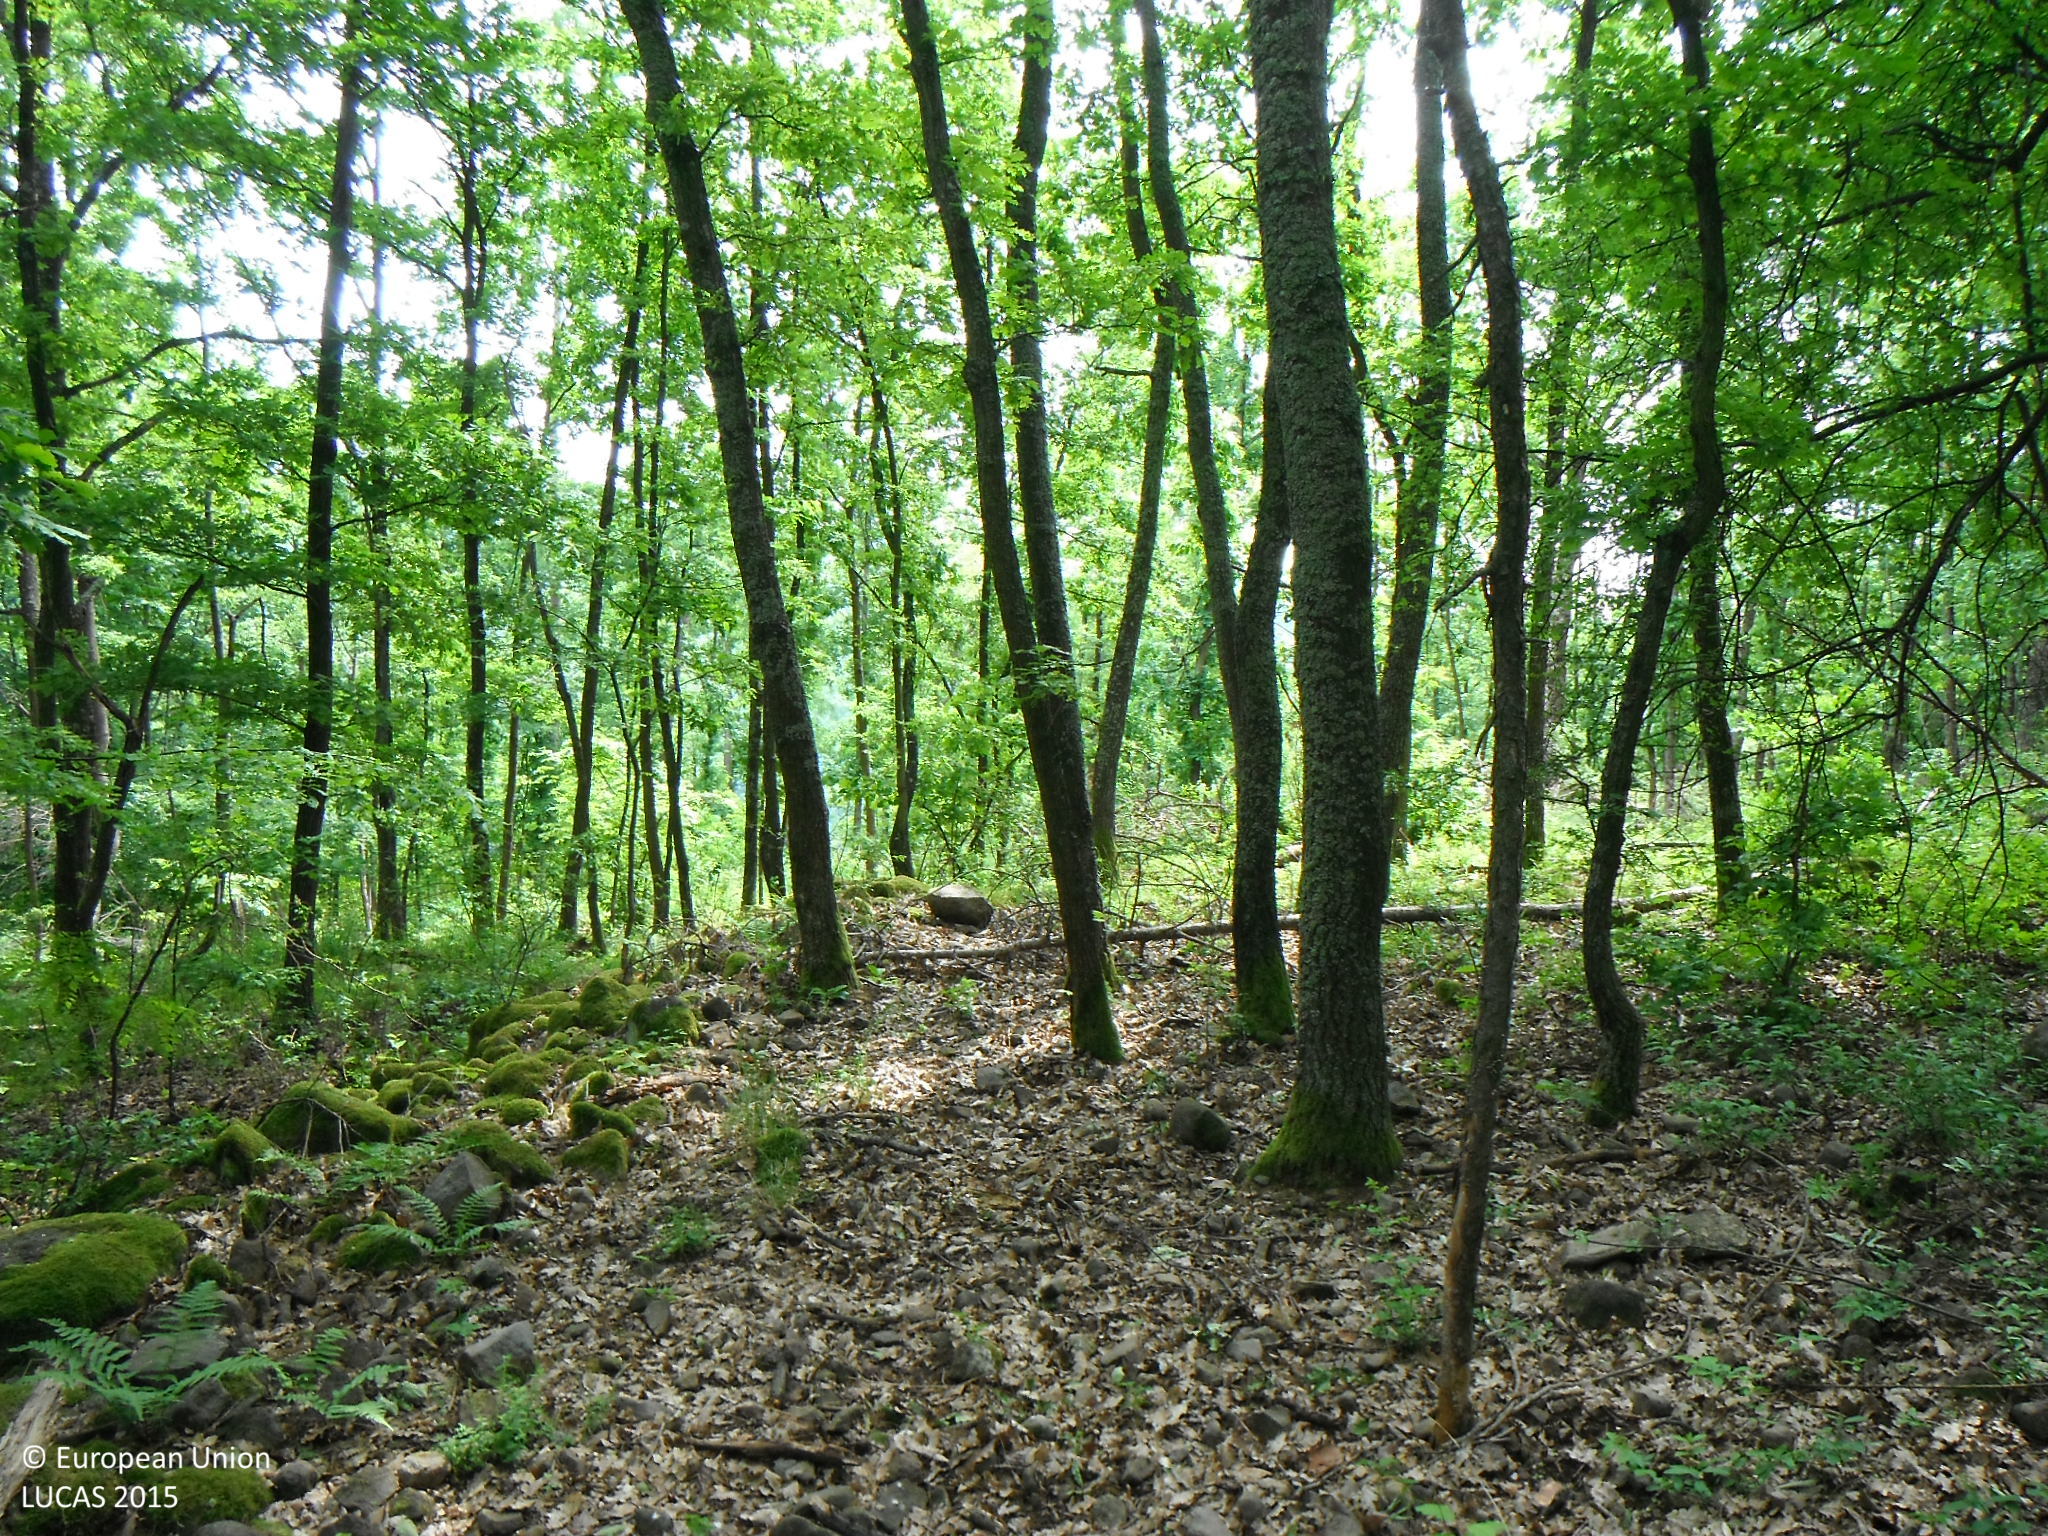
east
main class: Woodland
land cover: Broadleaved woodland
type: acidophilous oak and oak-birch forest
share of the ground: > 75 %
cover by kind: broadleaved forest trees 90 %, herbaceous plants 5 %, lichens and mosses 5 %
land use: Forestry
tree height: > 5 m
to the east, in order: Broadleaved woodland; Tracks; Broadleaved woodland; Spontaneously vegetated surfaces; Broadleaved woodland; Tracks; Broadleaved woodland
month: June
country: SK
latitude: 48.3463
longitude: 19.4012
